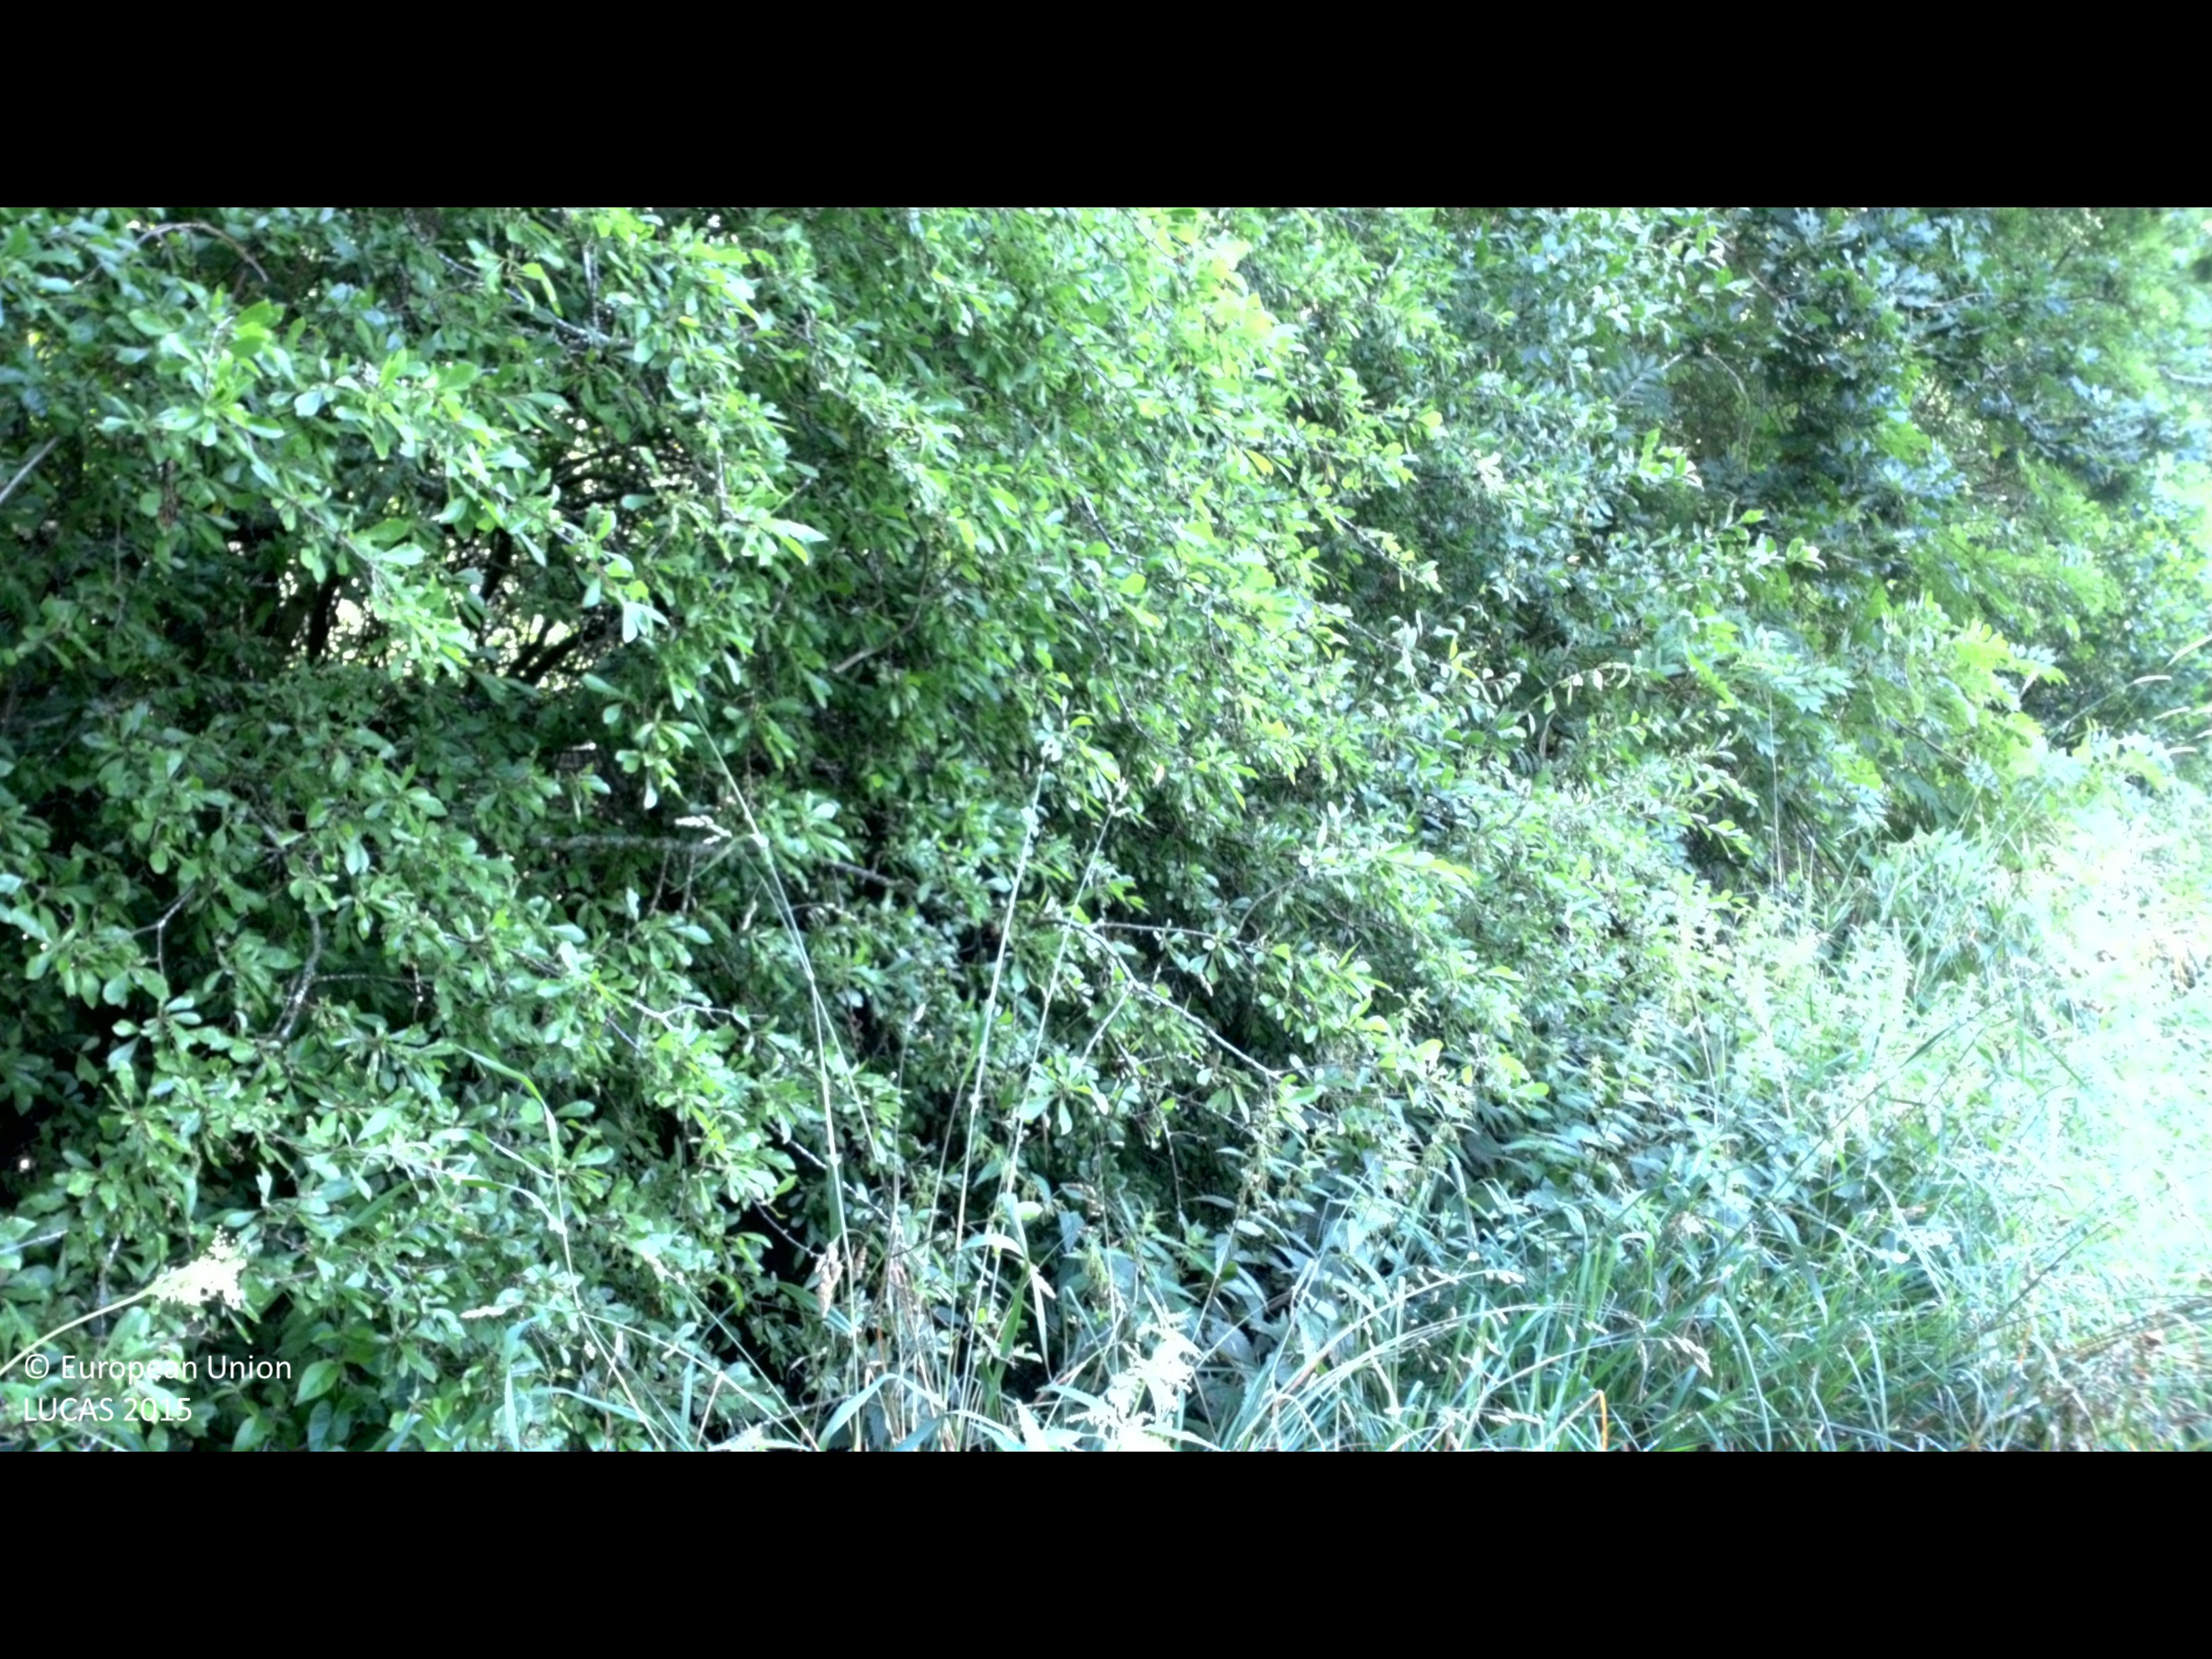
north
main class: Cropland
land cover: Dry pulses
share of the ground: > 75 %
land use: Agriculture (excluding fallow land and kitchen gardens)
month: July
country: SE
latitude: 56.6036
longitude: 16.4358
